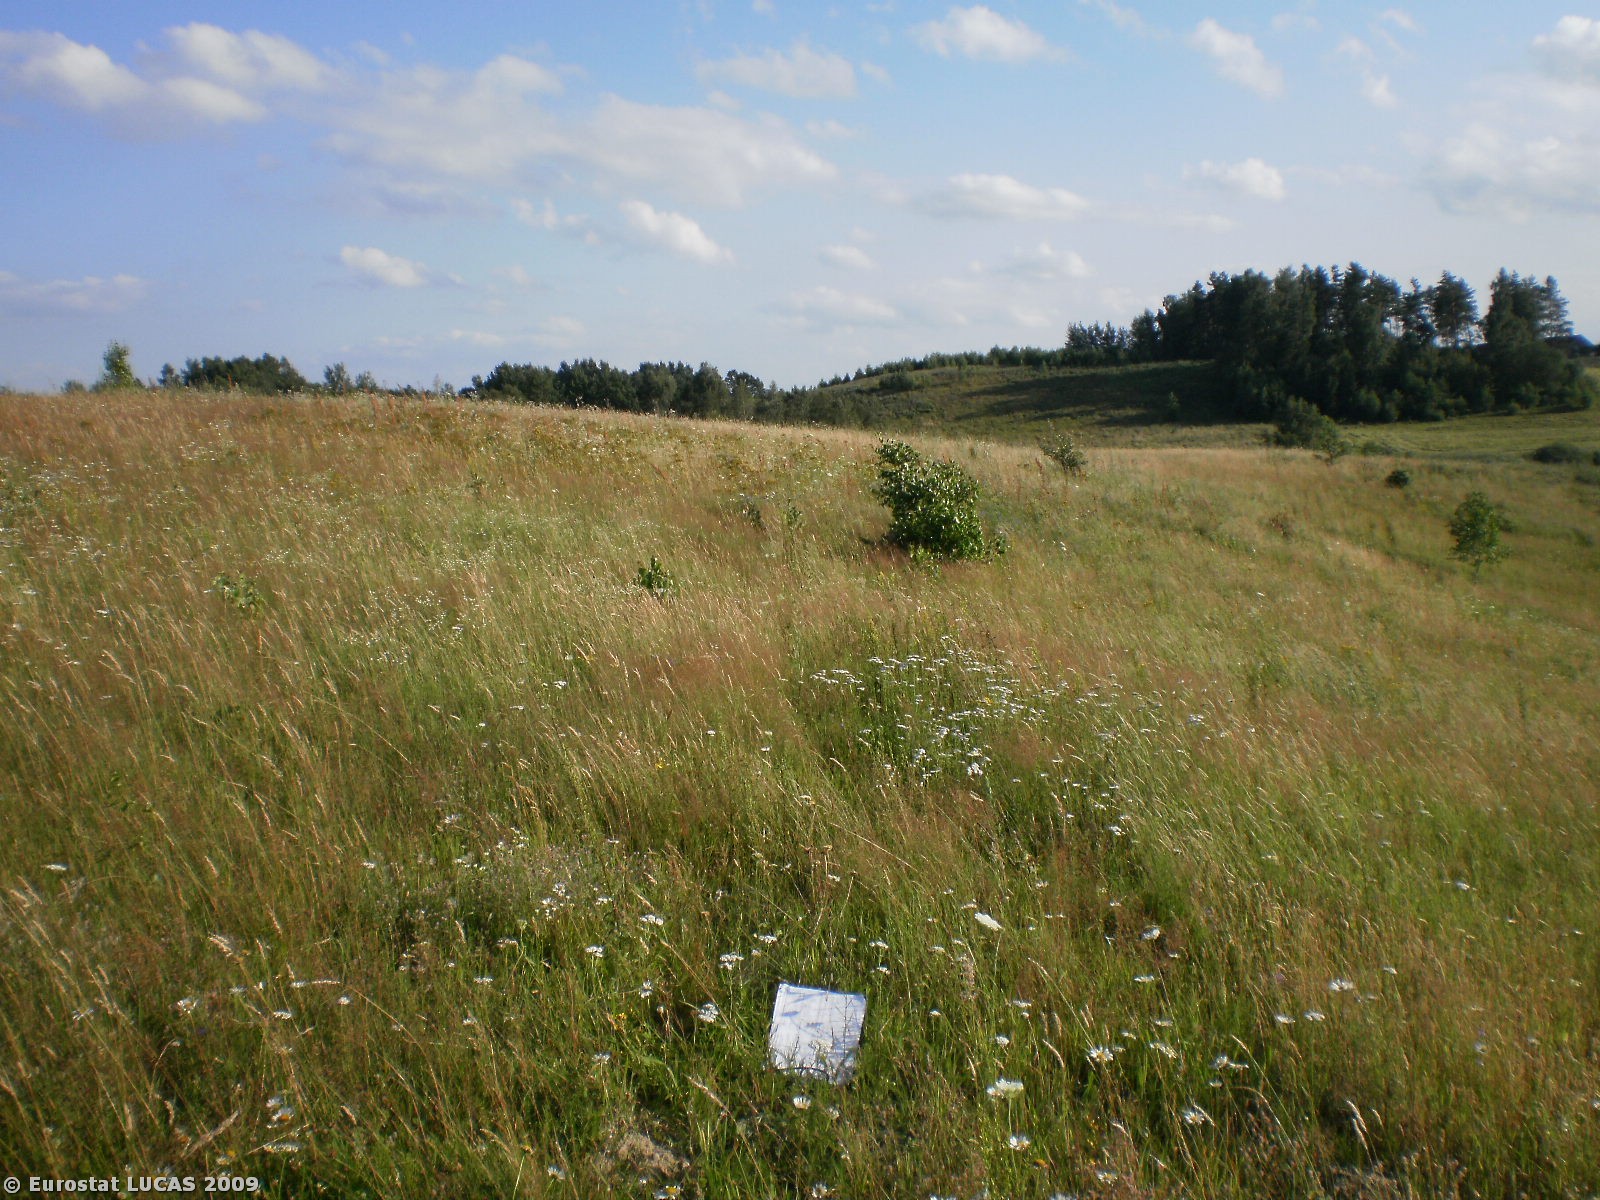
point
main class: Grassland
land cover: Grassland with sparse tree/shrub cover
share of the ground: > 75 %
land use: Unused
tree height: > 5 m
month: July
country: PL
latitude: 53.9691
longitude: 20.6021
